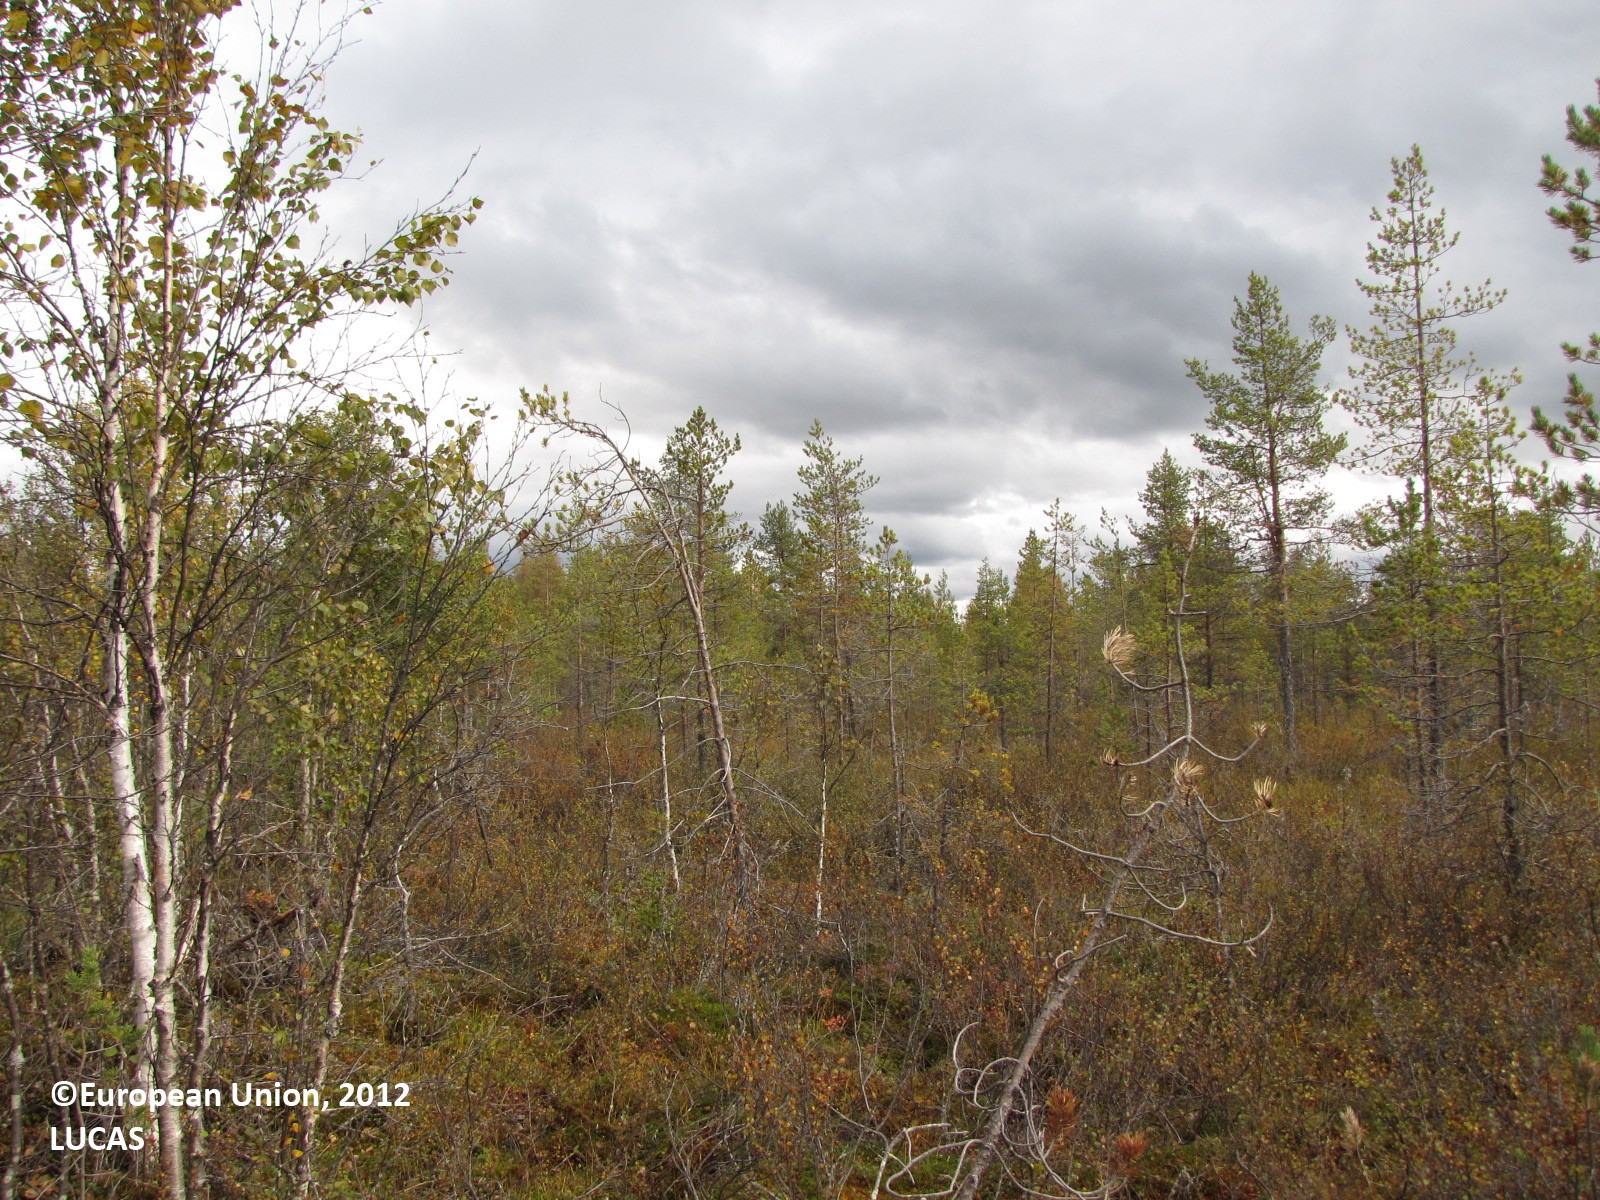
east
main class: Woodland
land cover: Pine dominated mixed woodland
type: boreal forest
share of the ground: 25 - 50 %
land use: Forestry
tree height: > 5 m
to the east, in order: Pine dominated mixed woodland; Spruce dominated mixed woodland; Rivers and streams; Broadleaved woodland; Ditches and canals; Broadleaved woodland; Ditches and canals; Broadleaved woodland; Ditches and canals; Spruce dominated mixed woodland; Ditches and canals; Spruce dominated mixed woodland
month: September
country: FI
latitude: 67.2227
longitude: 23.9838
